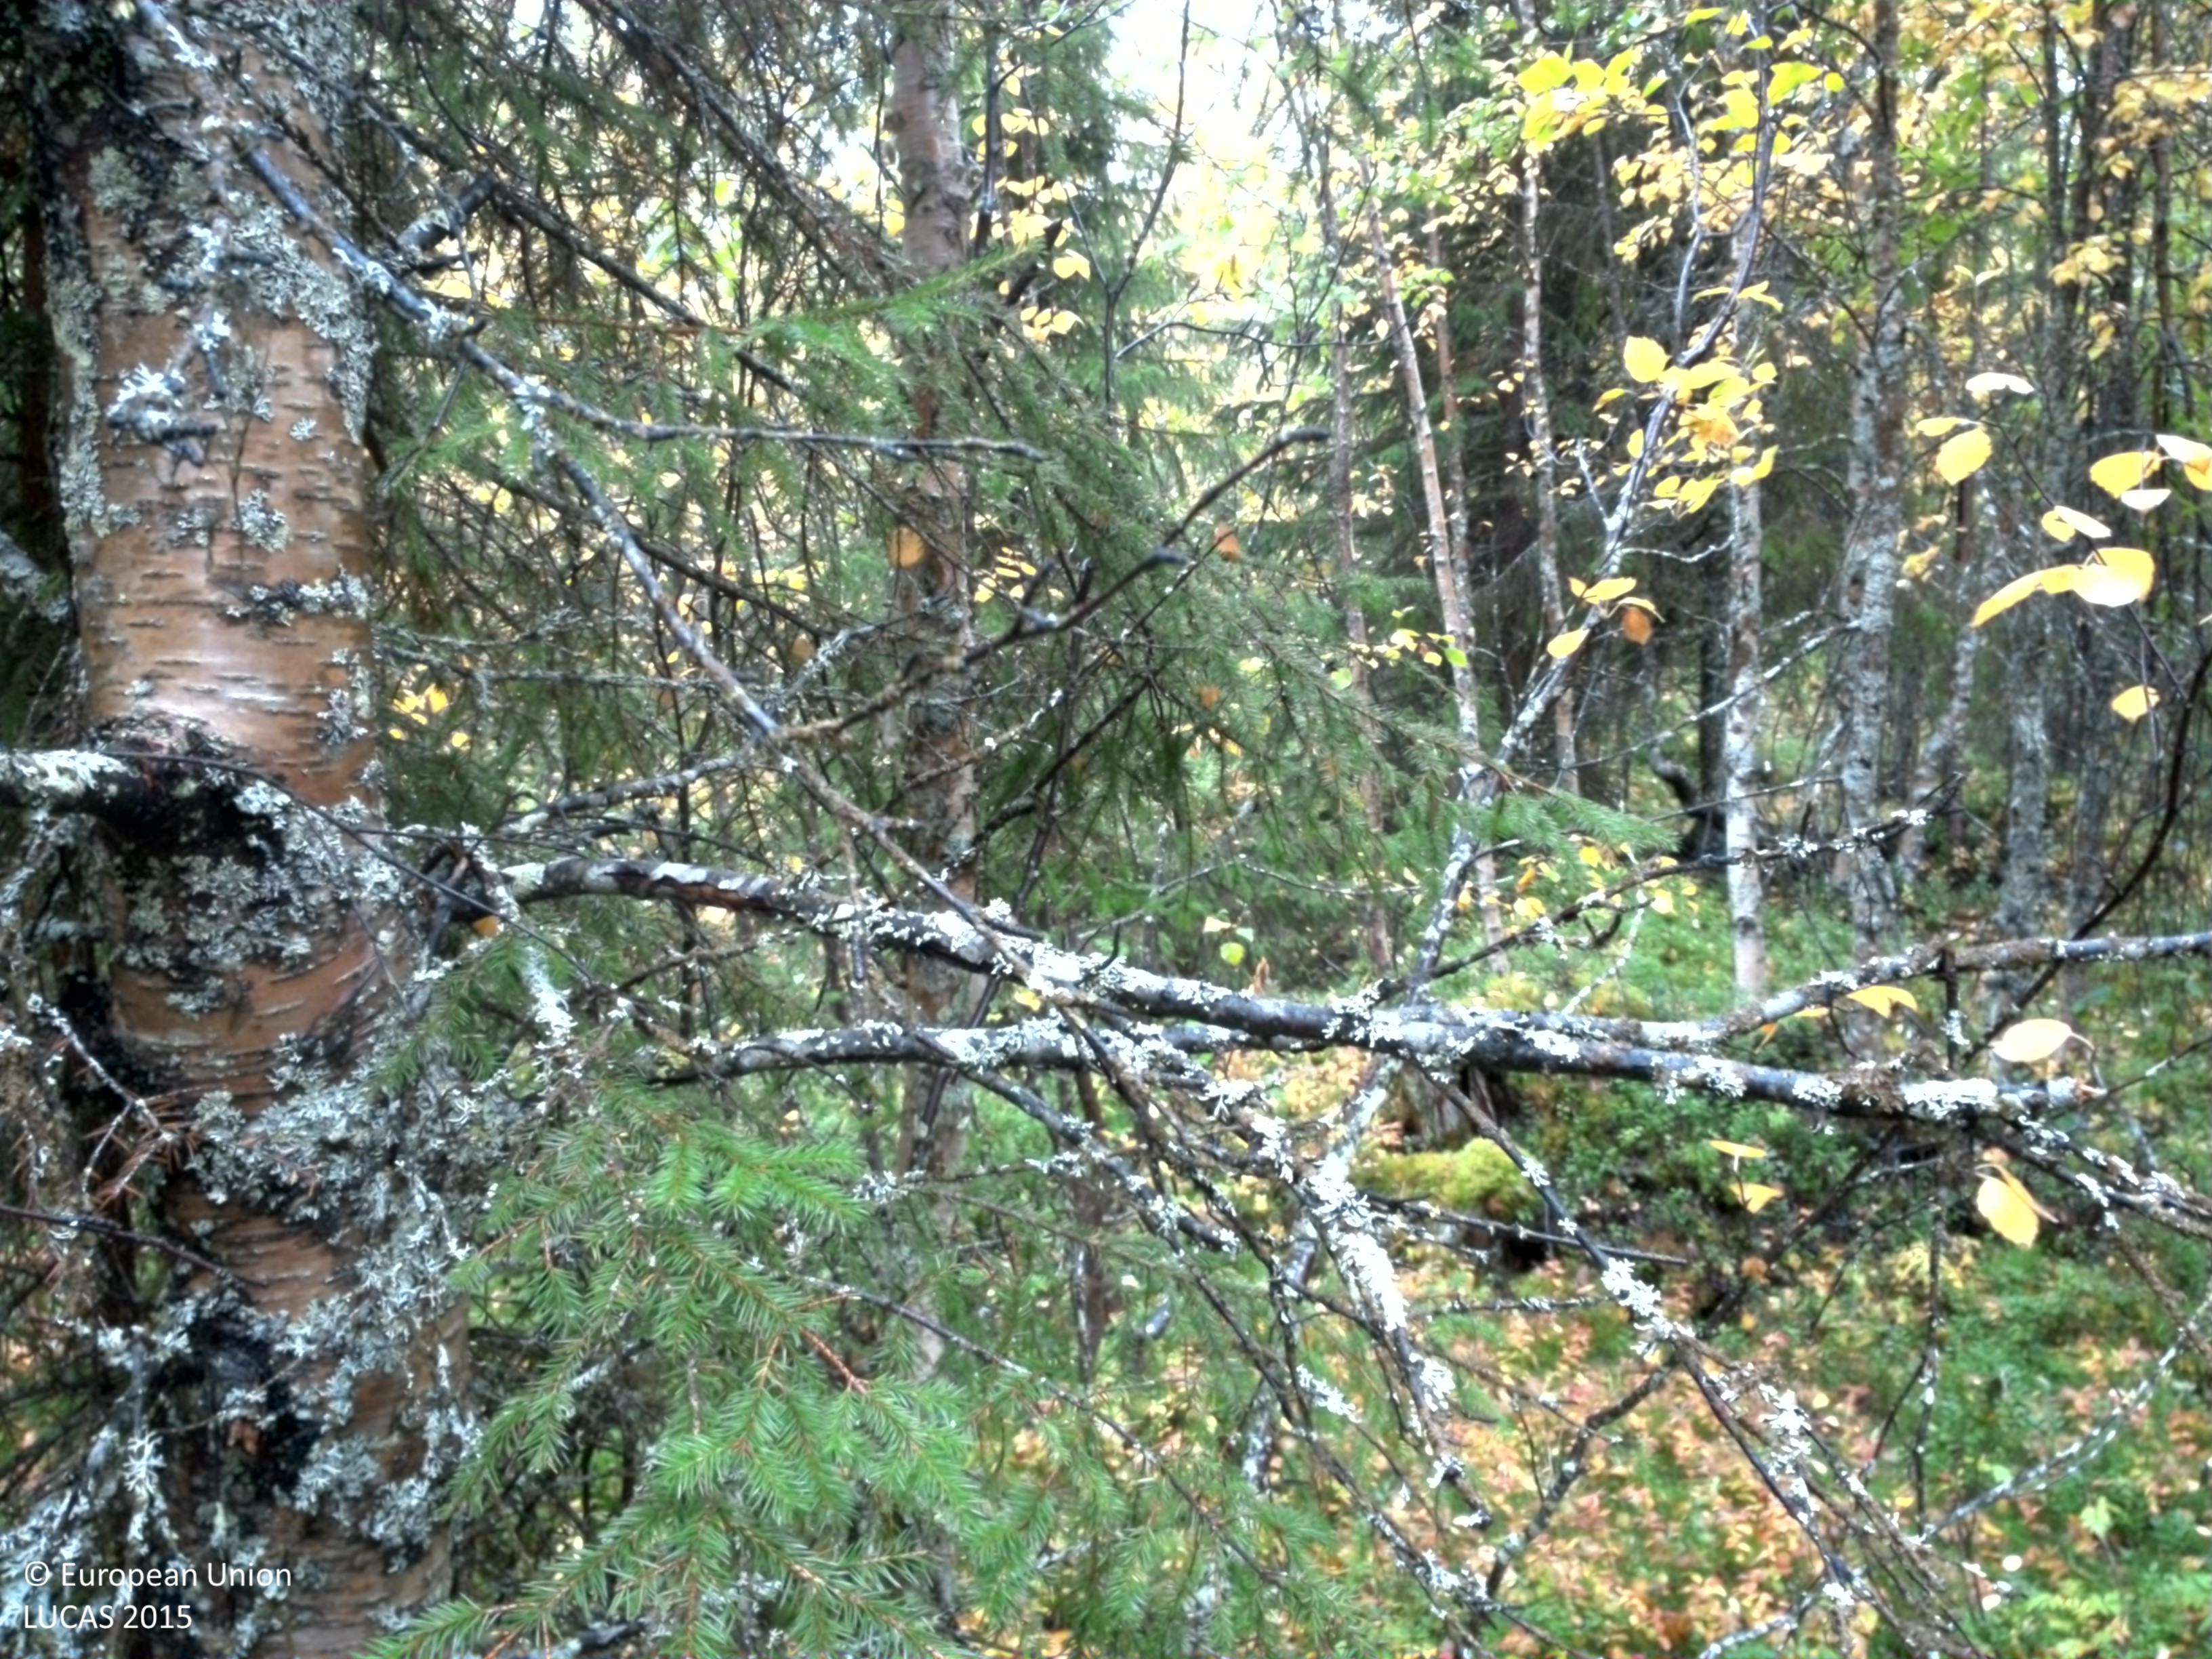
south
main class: Woodland
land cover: Spruce dominated mixed woodland
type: boreal forest
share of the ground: 50 - 75 %
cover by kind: coniferous forest trees 40 %, shrubs 25 %, broadleaved forest trees 20 %, herbaceous plants 10 %, lichens and mosses 5 %
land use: Forestry
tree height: > 5 m
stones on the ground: < 10 %
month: September
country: SE
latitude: 65.2332
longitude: 16.3174
